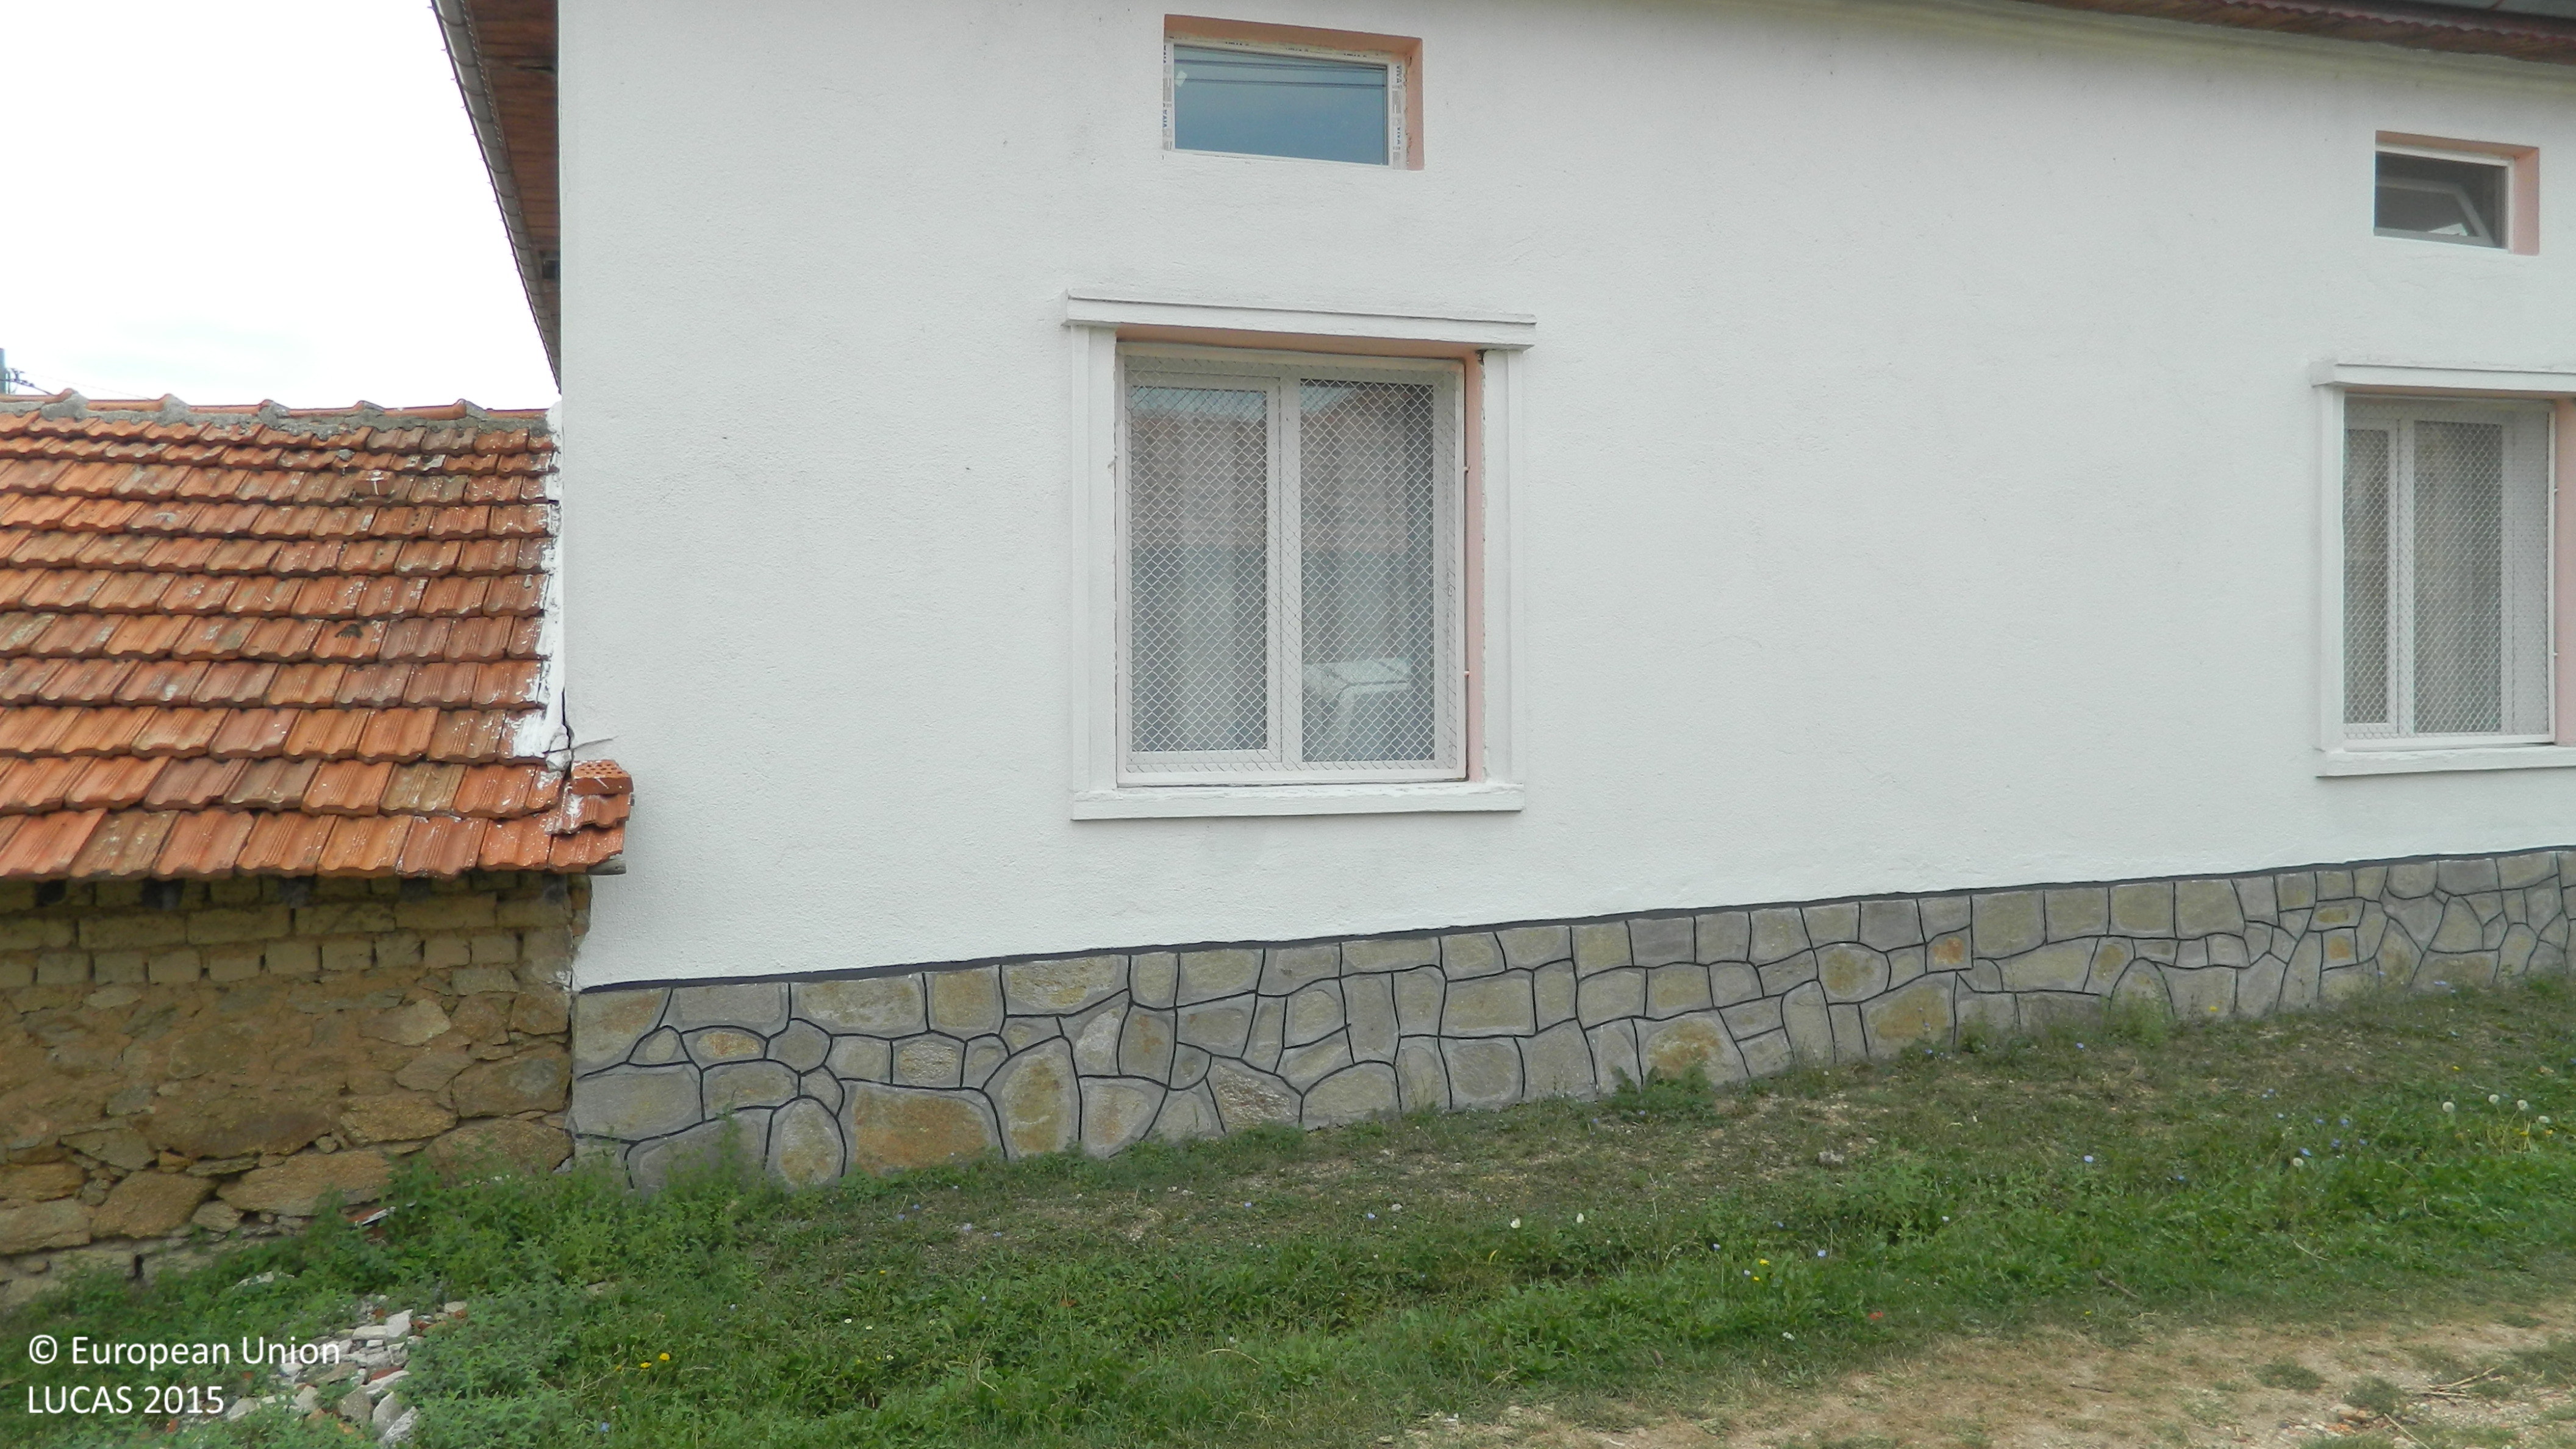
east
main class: Grassland
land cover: Grassland without tree/shrub cover
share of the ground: > 75 %
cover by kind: herbaceous plants 95 %, unconsolidated bare surface 5 %
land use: Residential
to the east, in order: Grassland without tree/shrub cover; Artificial constructions in urban areas; Grassland without tree/shrub cover
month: September
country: BG
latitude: 41.8416
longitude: 25.7100
